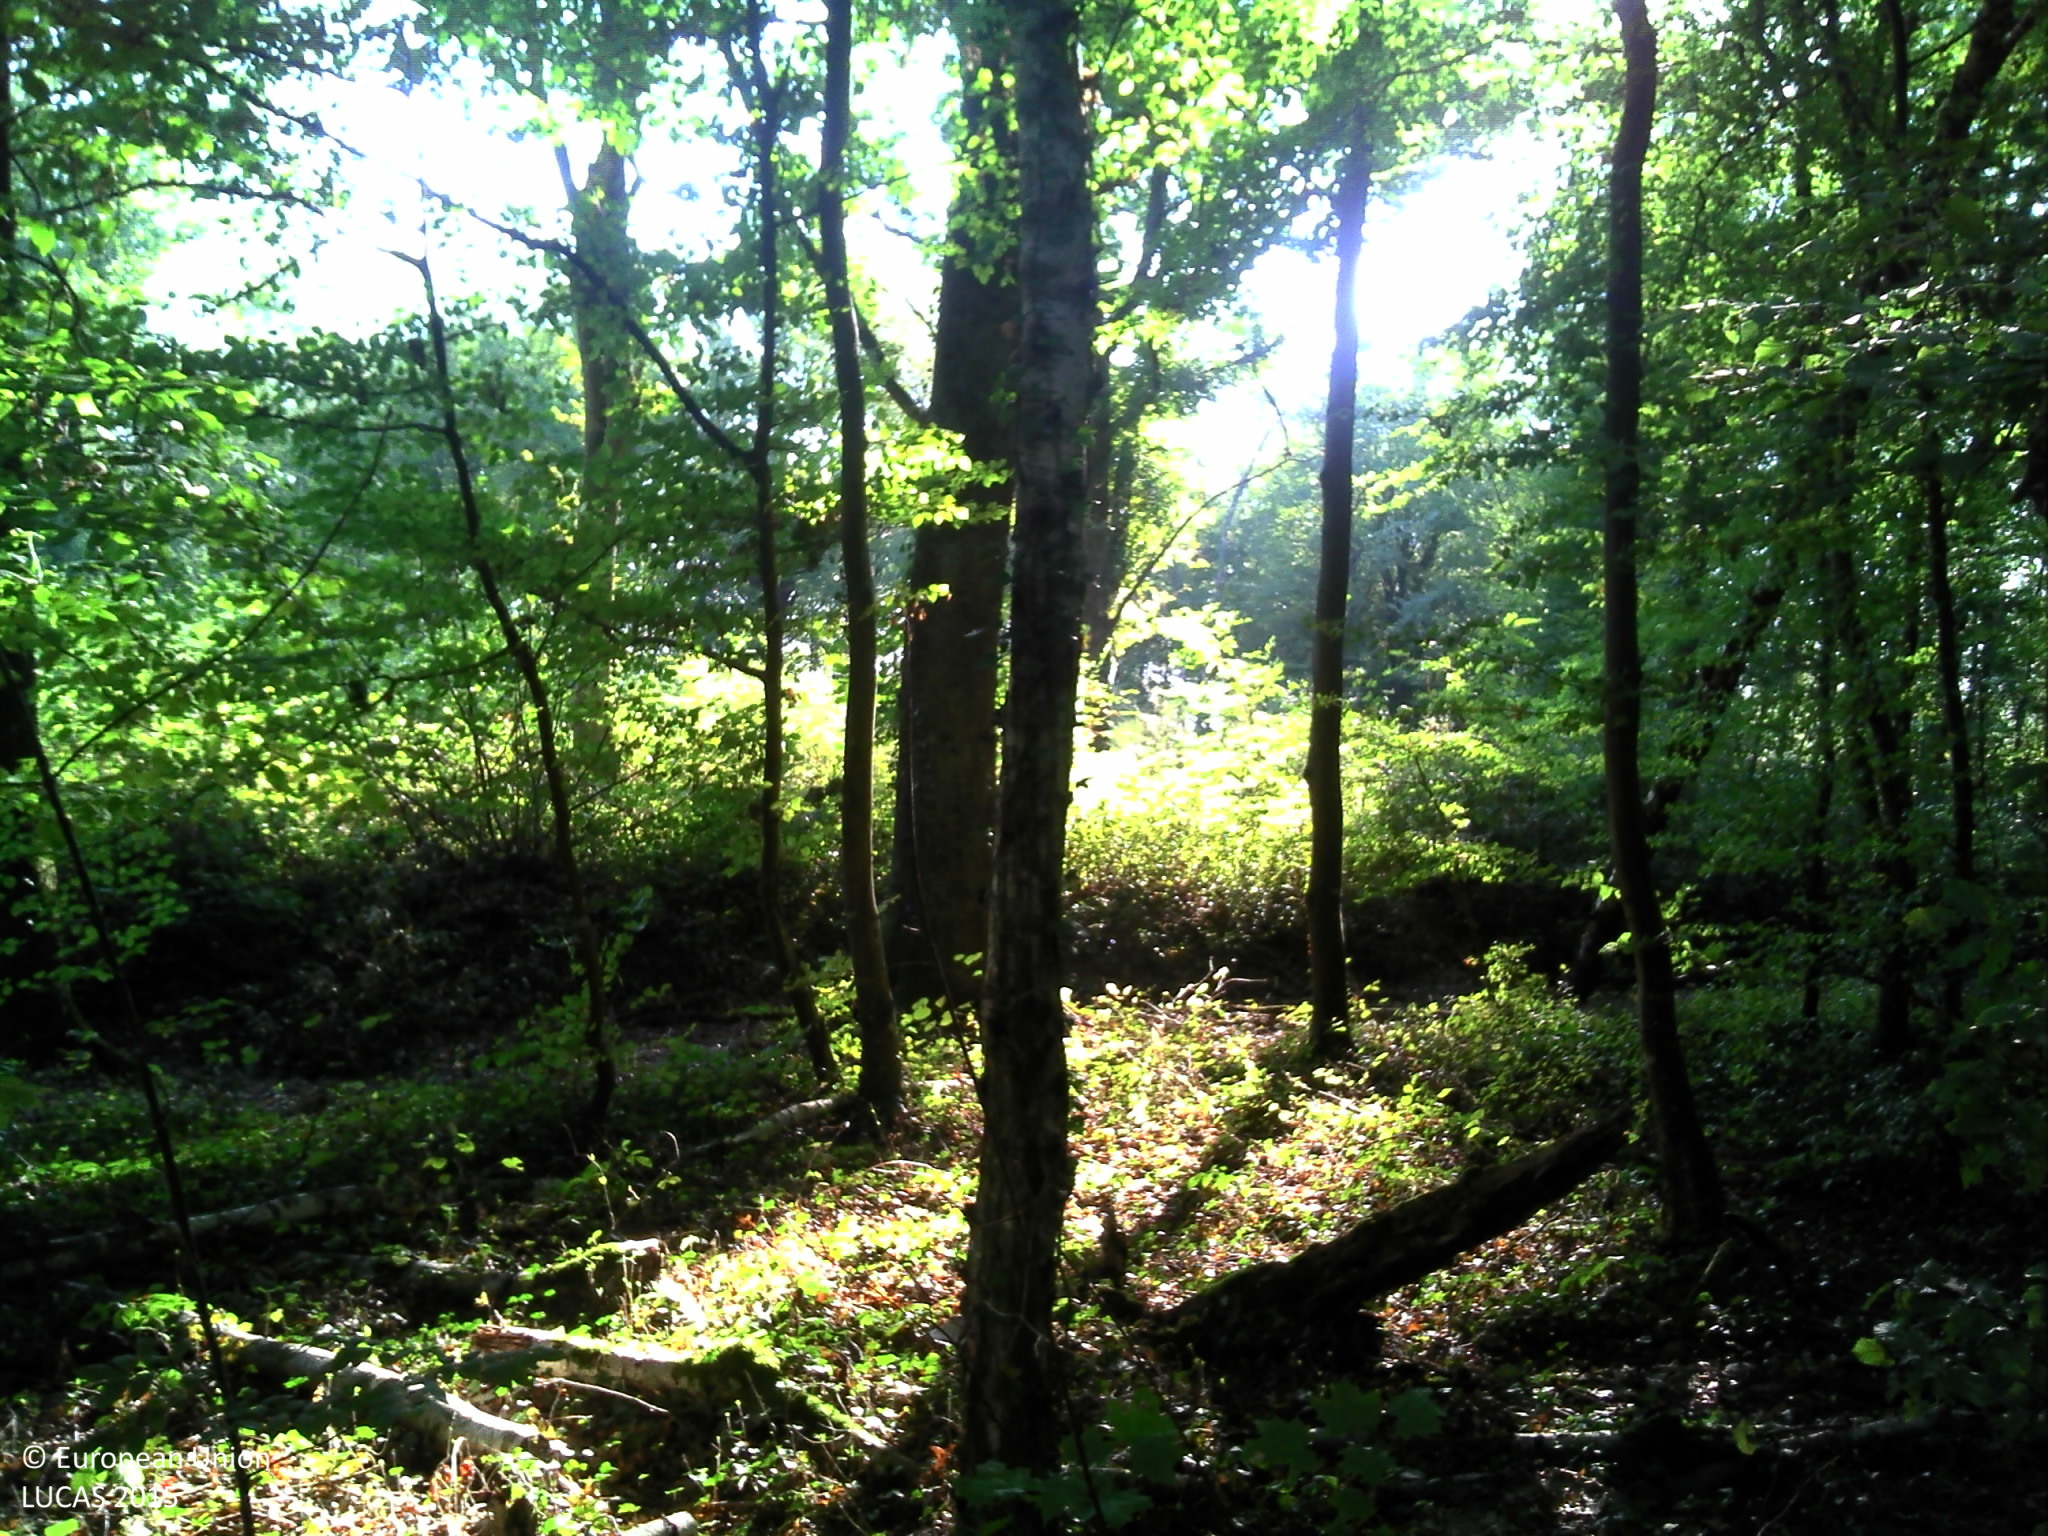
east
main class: Woodland
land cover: Broadleaved woodland
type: mesophytic deciduous forest
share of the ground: > 75 %
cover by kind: broadleaved forest trees 90 %, shrubs 5 %, herbaceous plants 5 %
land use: Forestry
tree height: > 5 m
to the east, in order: Broadleaved woodland; Ditches and canals; Broadleaved woodland; Spontaneously vegetated surfaces; Broadleaved woodland; Ditches and canals; Broadleaved woodland; Sunflower
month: October
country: FR
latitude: 45.9269
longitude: 4.9870
